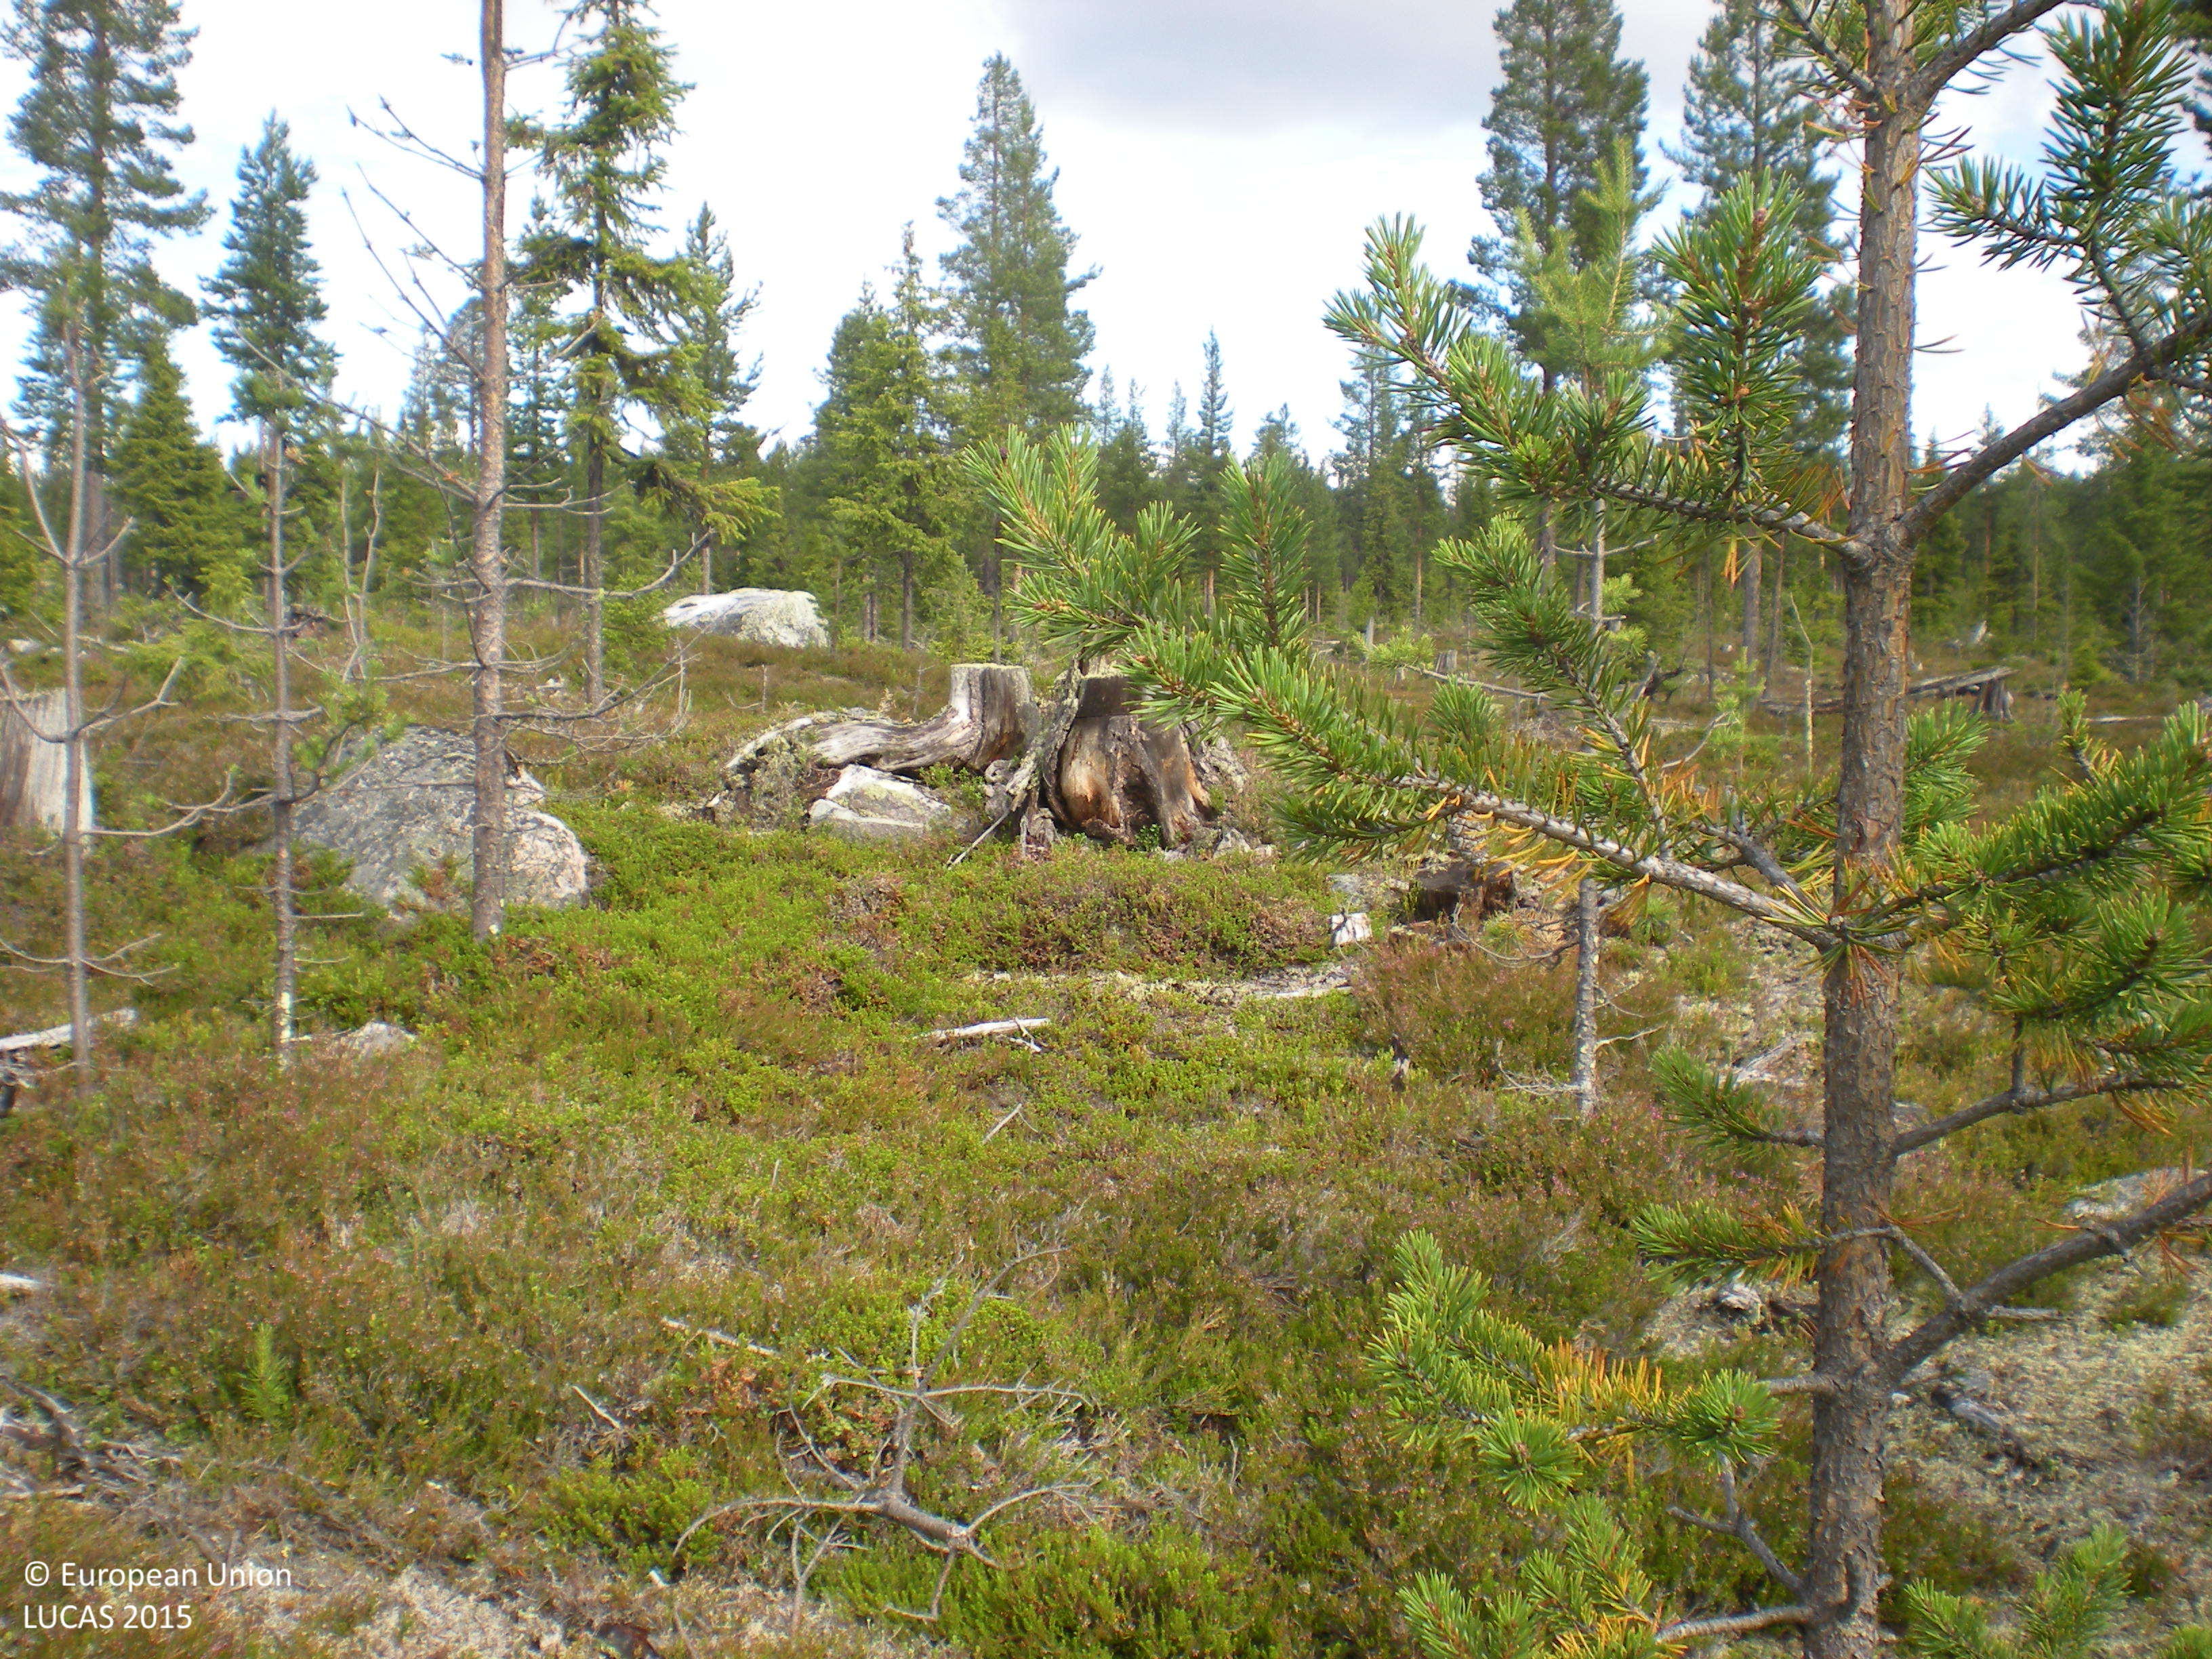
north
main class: Woodland
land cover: Pine dominated coniferous woodland
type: boreal forest
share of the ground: 25 - 50 %
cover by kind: shrubs 50 %, coniferous forest trees 30 %, lichens and mosses 10 %, consolidated bare surface 5 %
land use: Forestry
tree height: < 5 m
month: August
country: SE
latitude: 65.8464
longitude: 18.0824
